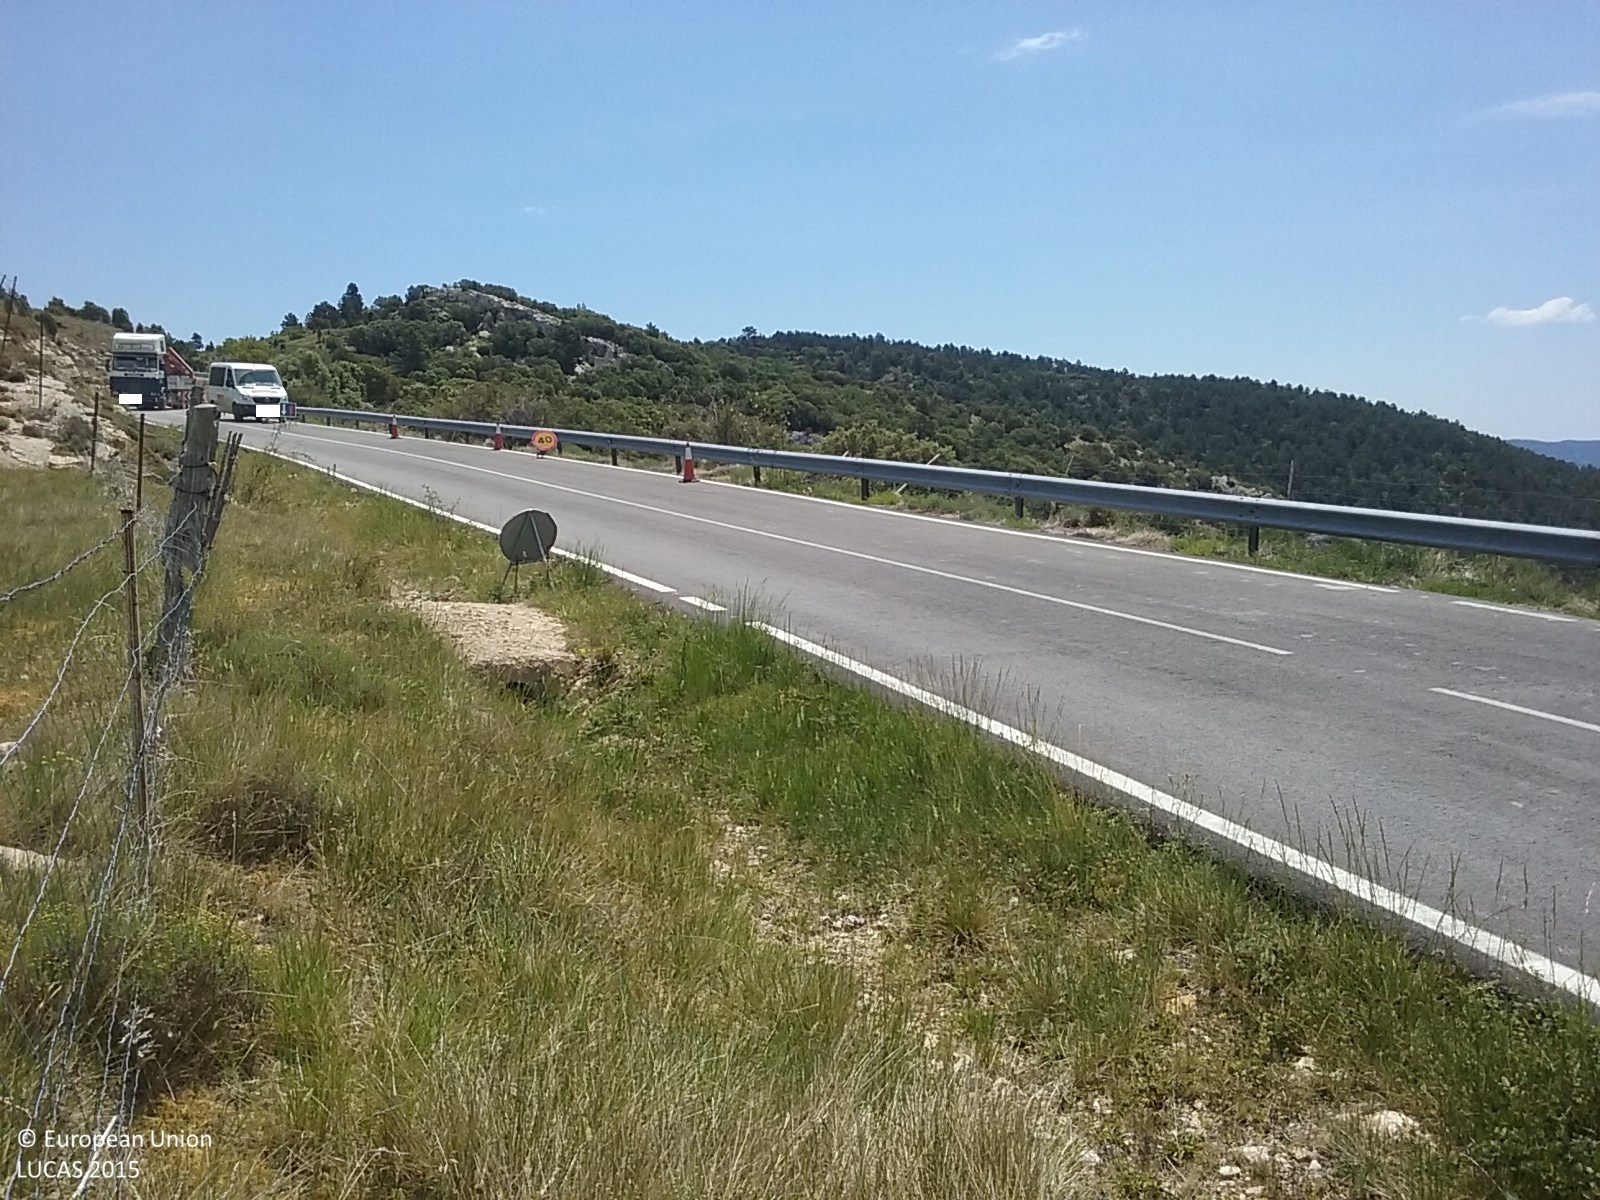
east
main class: Shrubland
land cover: Shrubland with sparse tree cover
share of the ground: 25 - 50 %
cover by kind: unconsolidated bare surface 65 %, shrubs 20 %, herbaceous plants 10 %, coniferous forest trees 5 %
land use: Semi-natural and natural areas not in use
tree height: < 5 m
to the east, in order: Shrubland with sparse tree cover; Dry stone walls; Shrubland with sparse tree cover; Dry stone walls; Shrubland with sparse tree cover; Dry stone walls; Shrubland with sparse tree cover
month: June
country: ES
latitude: 40.6501
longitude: 0.0236
